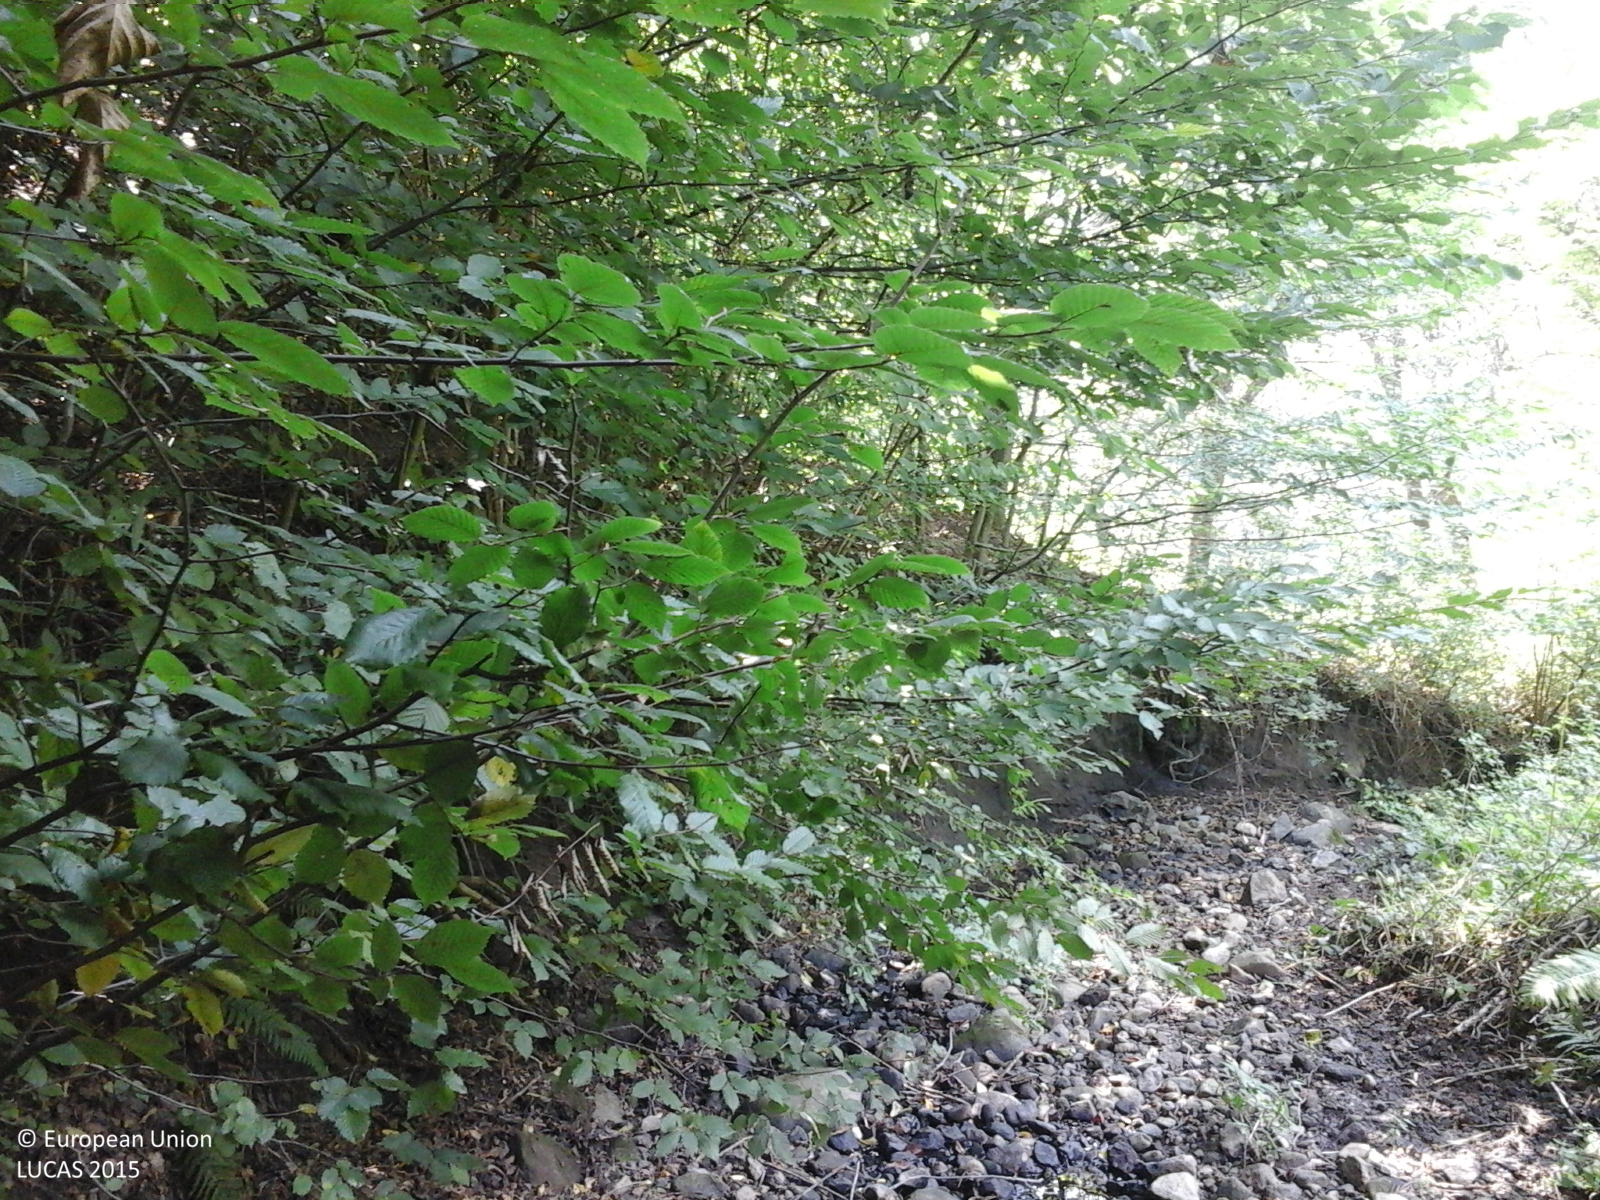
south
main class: Woodland
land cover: Broadleaved woodland
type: broadleaved evergreen forest
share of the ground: > 75 %
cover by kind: broadleaved forest trees 100 %
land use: Forestry
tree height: > 5 m
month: August
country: RO
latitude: 46.2919
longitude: 22.4725
